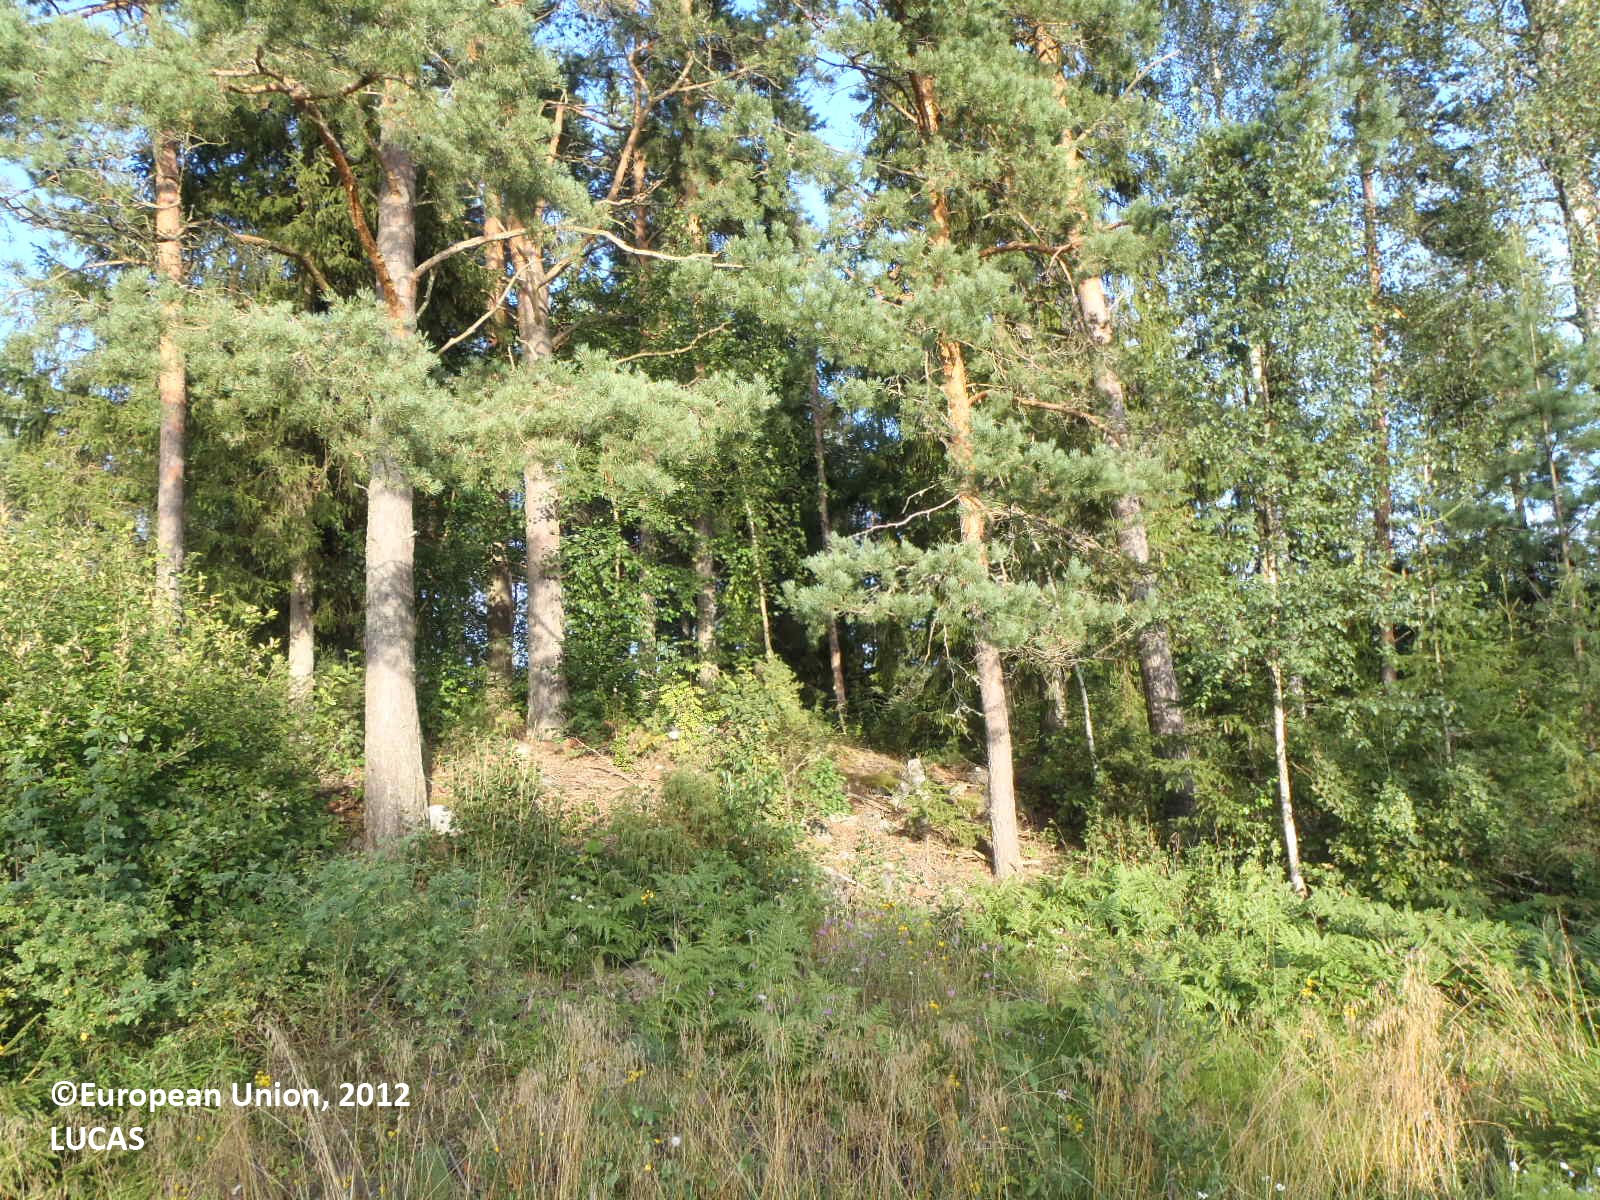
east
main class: Cropland
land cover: Temporary grasslands
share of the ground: > 75 %
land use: Agriculture (excluding fallow land and kitchen gardens)
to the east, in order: Temporary grasslands; Grass margins; Ditches and canals; Pine dominated coniferous woodland; Rock outcrops; Pine dominated coniferous woodland; Tracks; Pine dominated mixed woodland; Tracks; Grass margins; Other bare soil; Barley; Grass margins; Ditches and canals; Grass margins; Common wheat
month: August
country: FI
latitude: 60.2840
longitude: 22.2392
